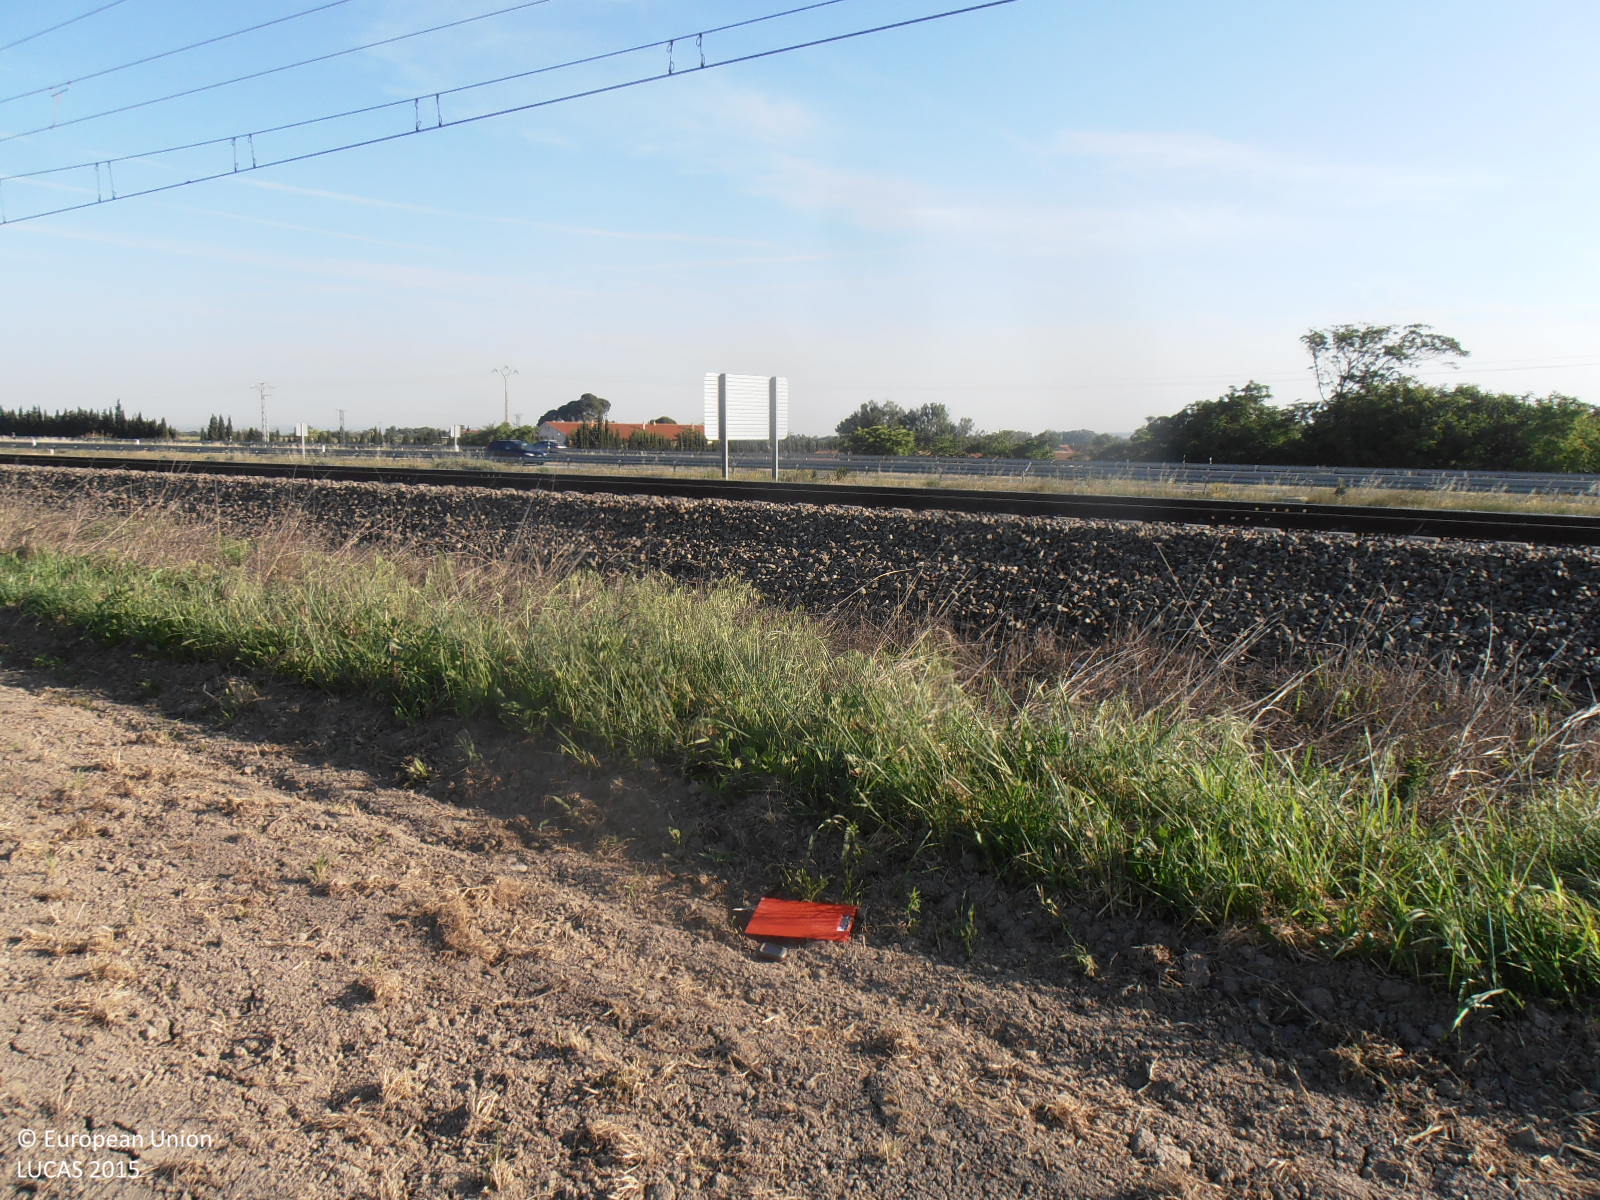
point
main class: Cropland
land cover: Maize
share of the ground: < 10 %
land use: Agriculture (excluding fallow land and kitchen gardens)
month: May
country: ES
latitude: 41.5853
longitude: -0.7801
